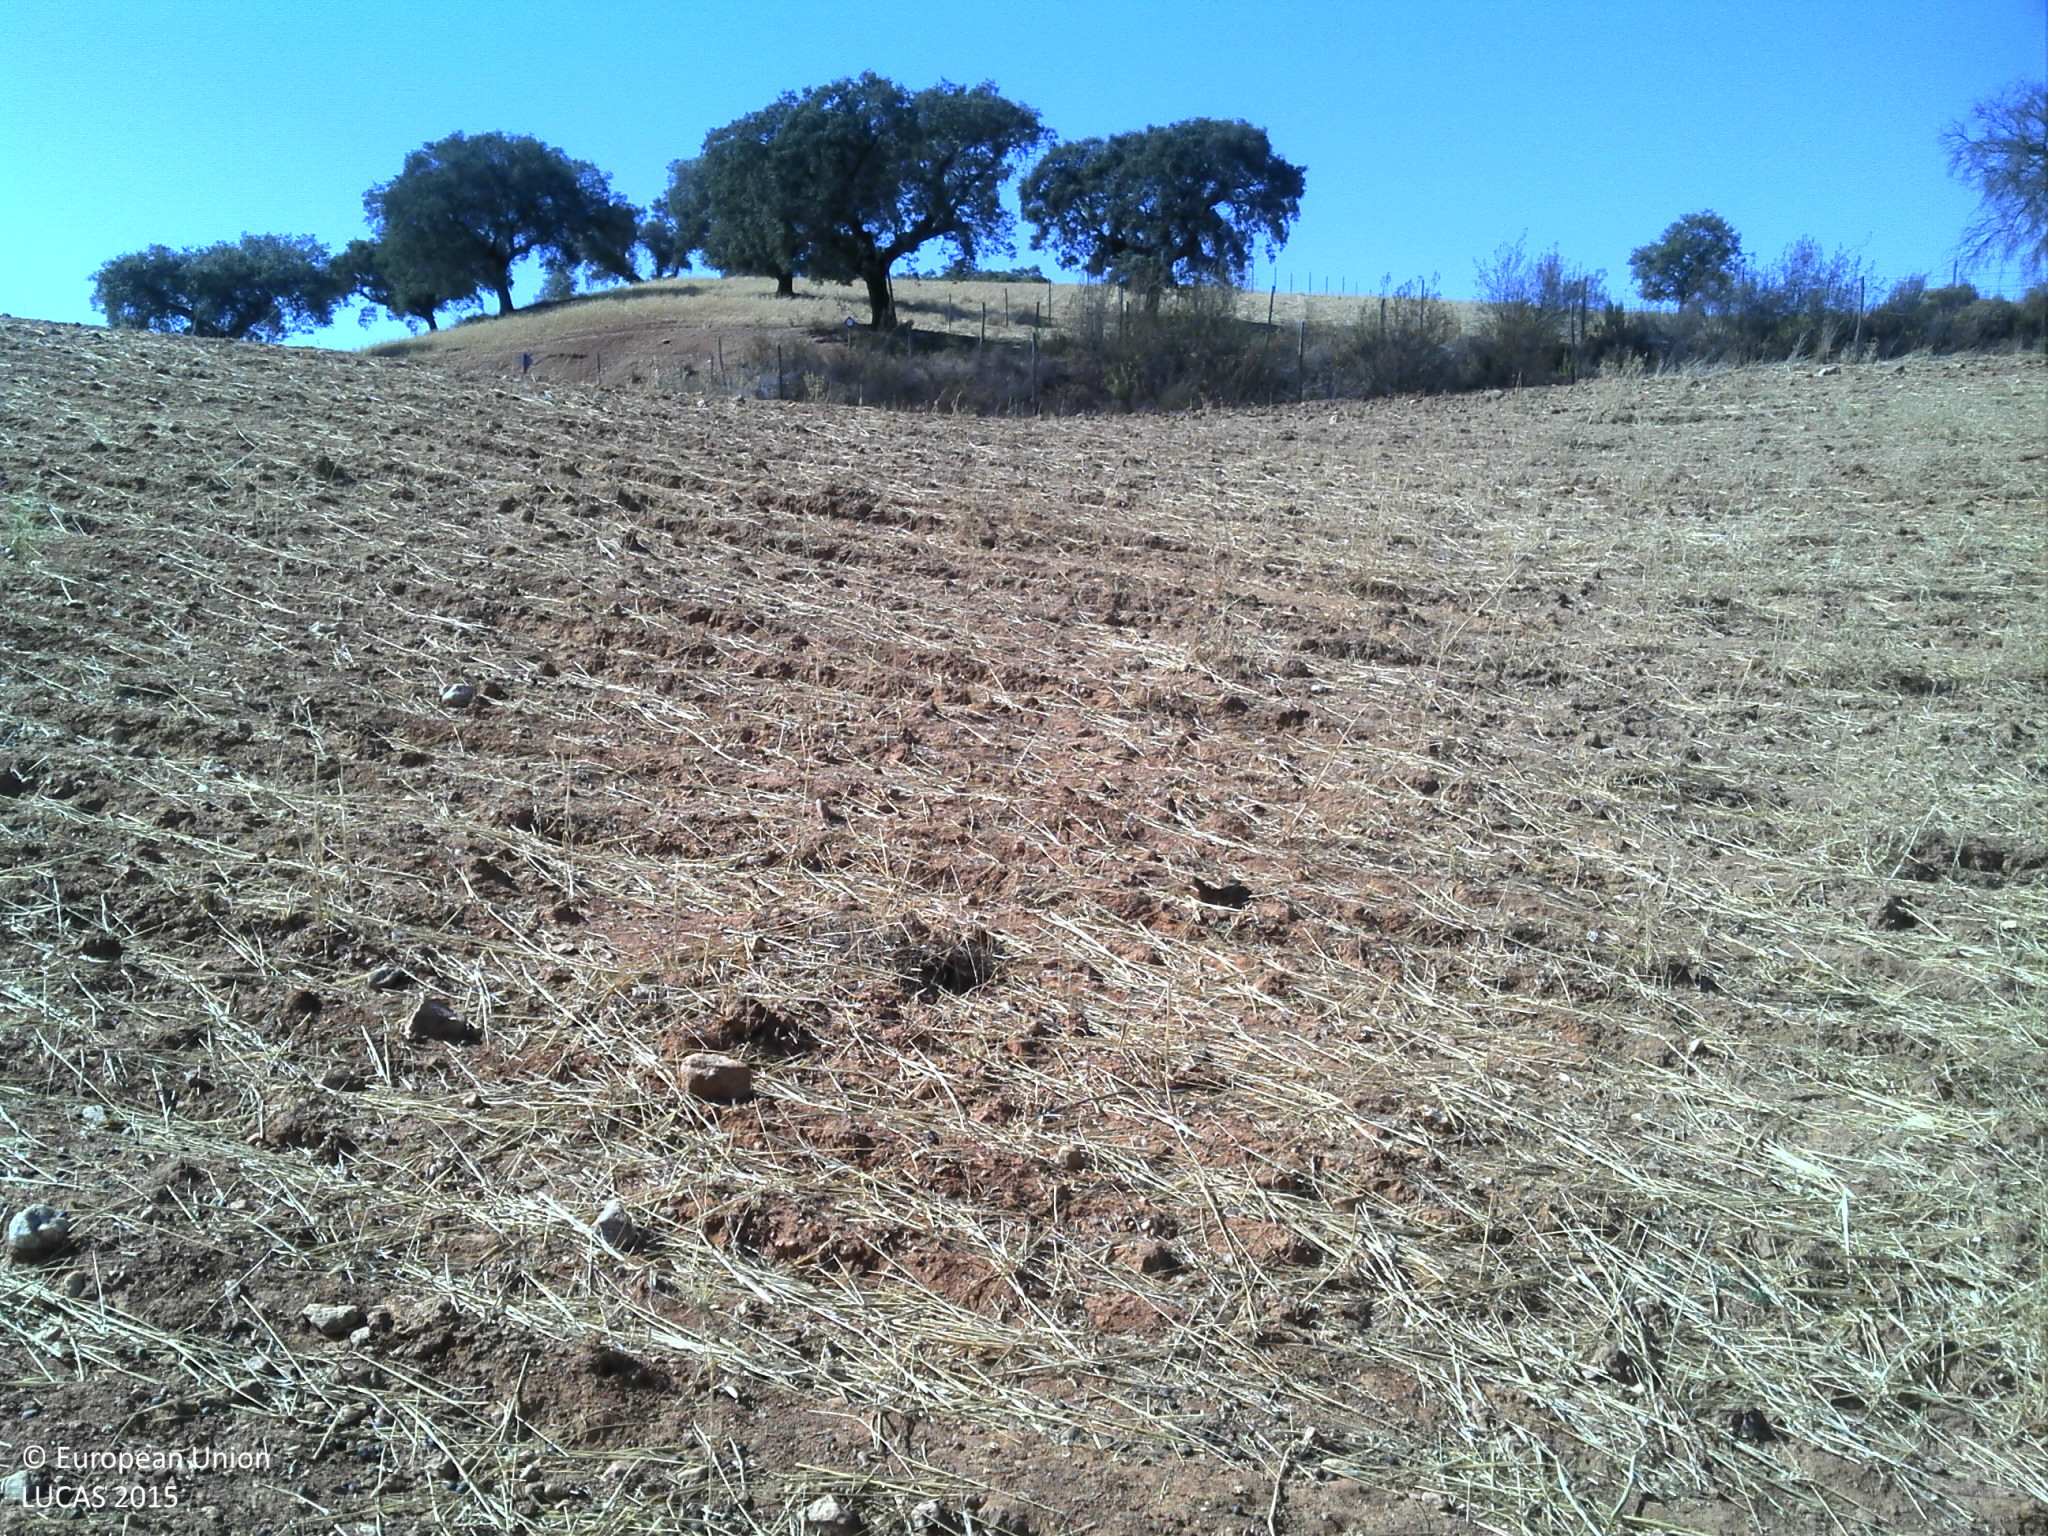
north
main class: Grassland
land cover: Grassland without tree/shrub cover
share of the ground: 10 - 25 %
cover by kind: unconsolidated bare surface 80 %, herbaceous plants 20 %
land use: Agriculture (excluding fallow land and kitchen gardens)
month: July
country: PT
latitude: 38.1703
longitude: -7.6613
